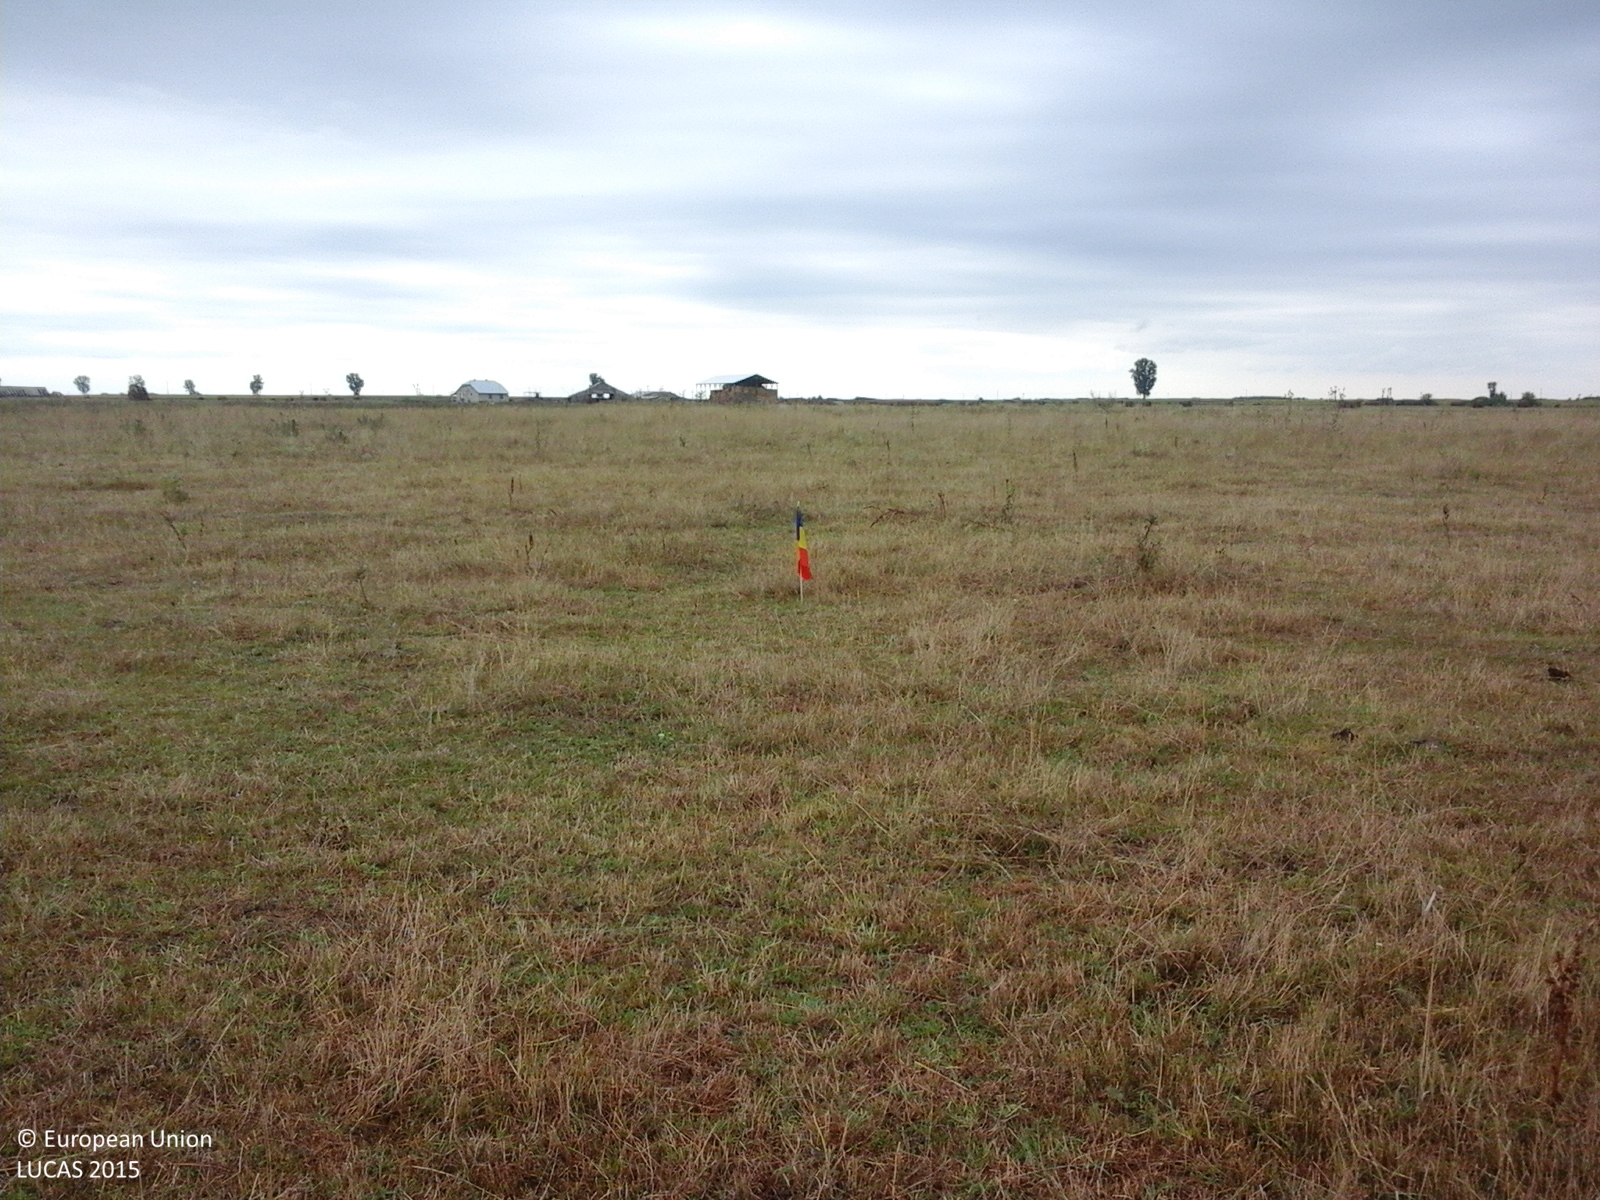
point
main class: Grassland
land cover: Grassland without tree/shrub cover
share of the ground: > 75 %
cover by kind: herbaceous plants 100 %
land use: Agriculture (excluding fallow land and kitchen gardens)
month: August
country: RO
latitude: 45.5348
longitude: 21.1047
